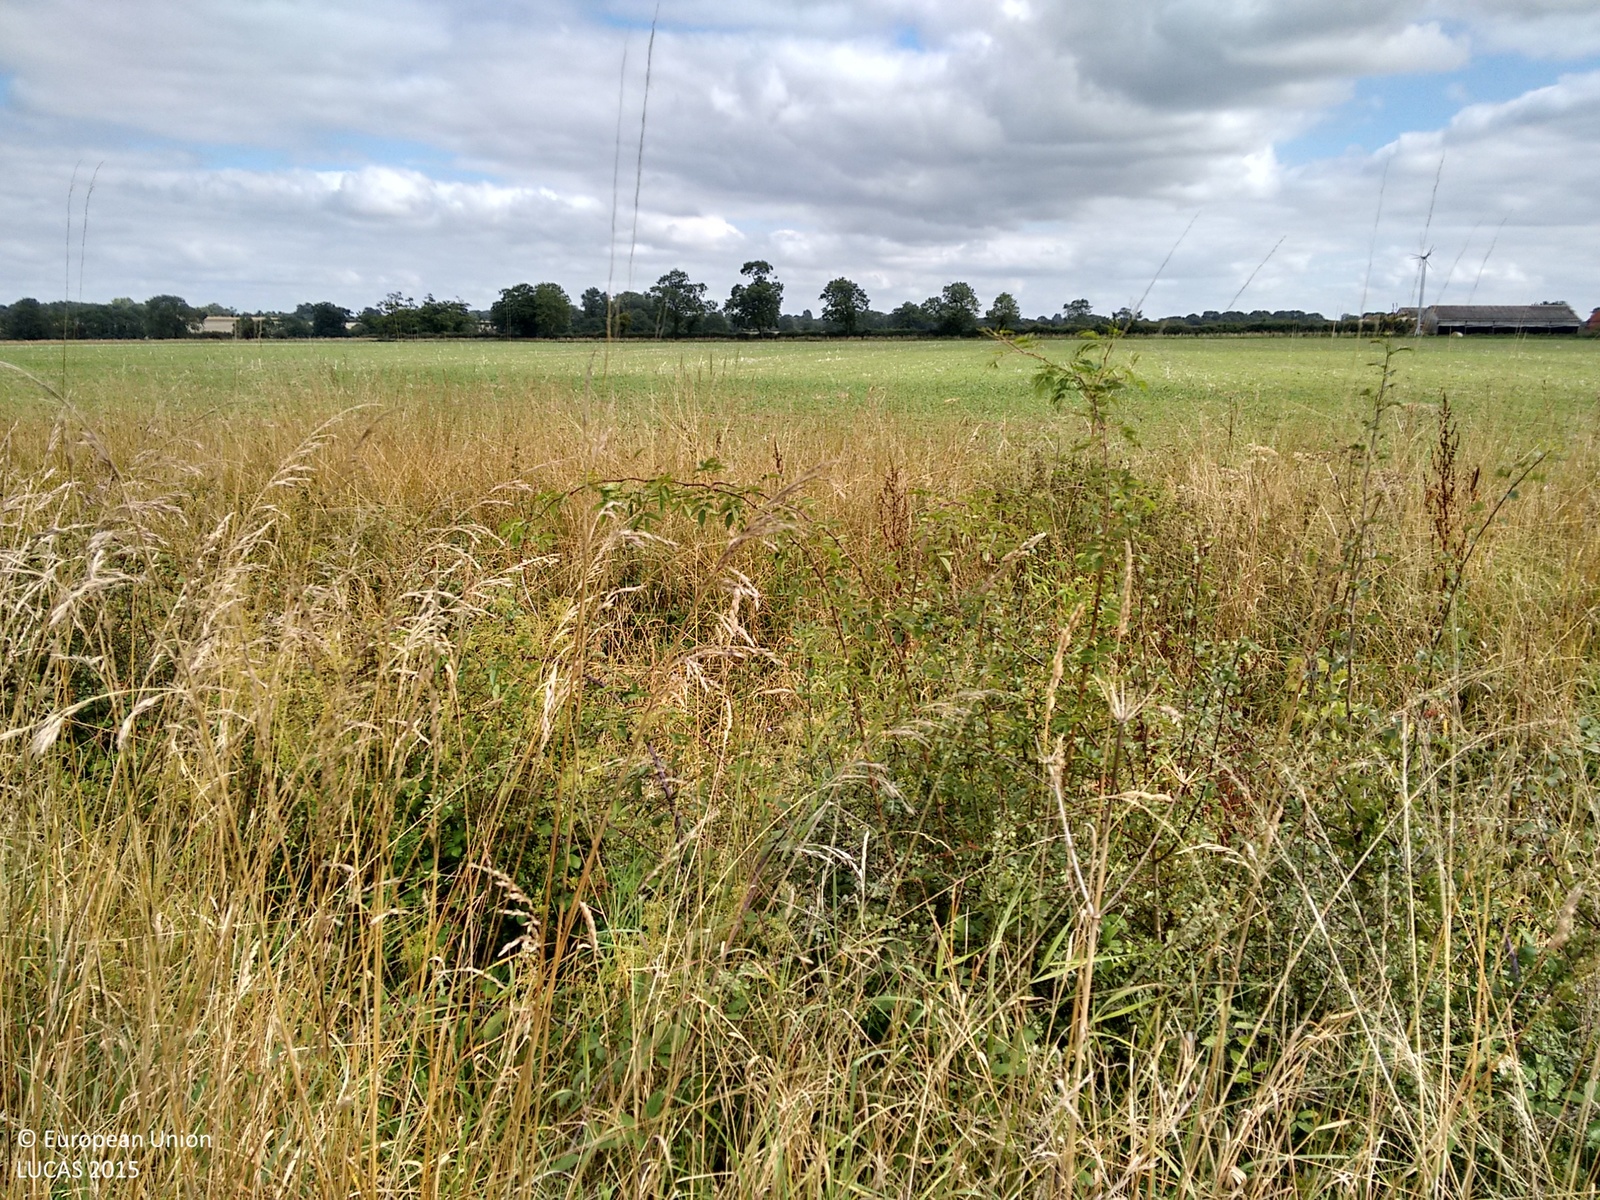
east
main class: Cropland
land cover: Common wheat
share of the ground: > 75 %
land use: Agriculture (excluding fallow land and kitchen gardens)
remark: Harvested field
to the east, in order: Common wheat; Grassland without tree/shrub cover; Ditches and canals; Abandoned hedges; Grass margins; Sugar beet
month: September
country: GB
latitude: 52.6170
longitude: 0.8031
